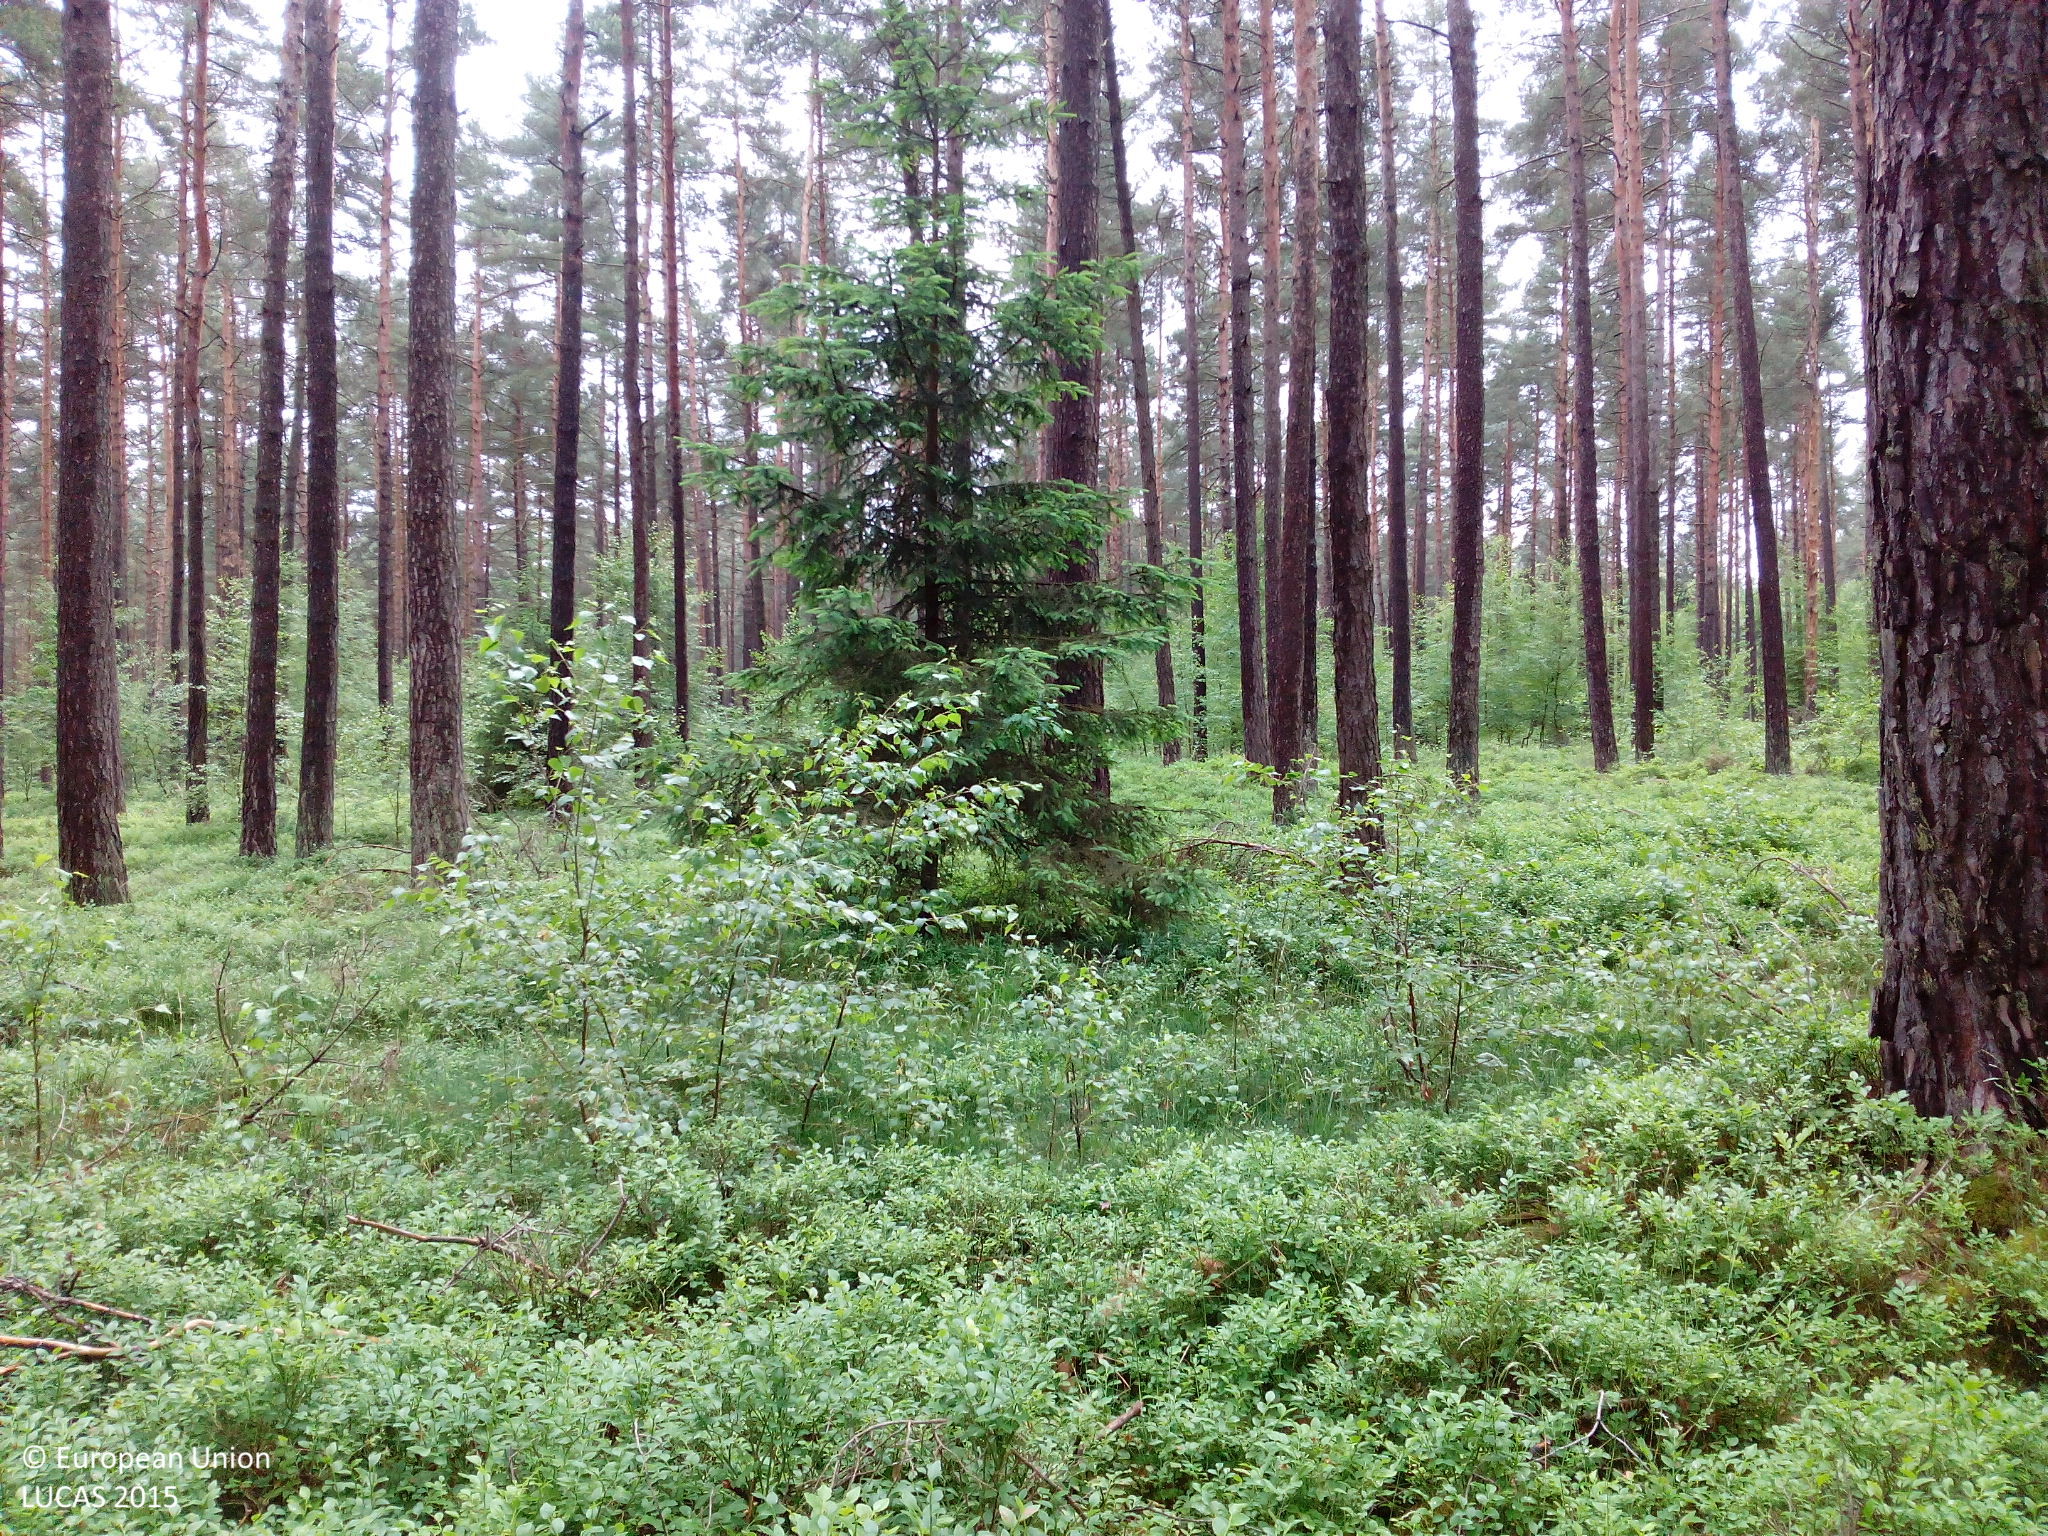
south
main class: Woodland
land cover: Pine dominated coniferous woodland
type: hemiboreal forest and nemoral coniferous forest and mixed broadleaved-coniferous forest
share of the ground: 25 - 50 %
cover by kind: coniferous forest trees 45 %, shrubs 35 %, broadleaved forest trees 10 %, herbaceous plants 10 %
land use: Forestry
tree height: > 5 m
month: June
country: DE
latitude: 49.2992
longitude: 12.2135
